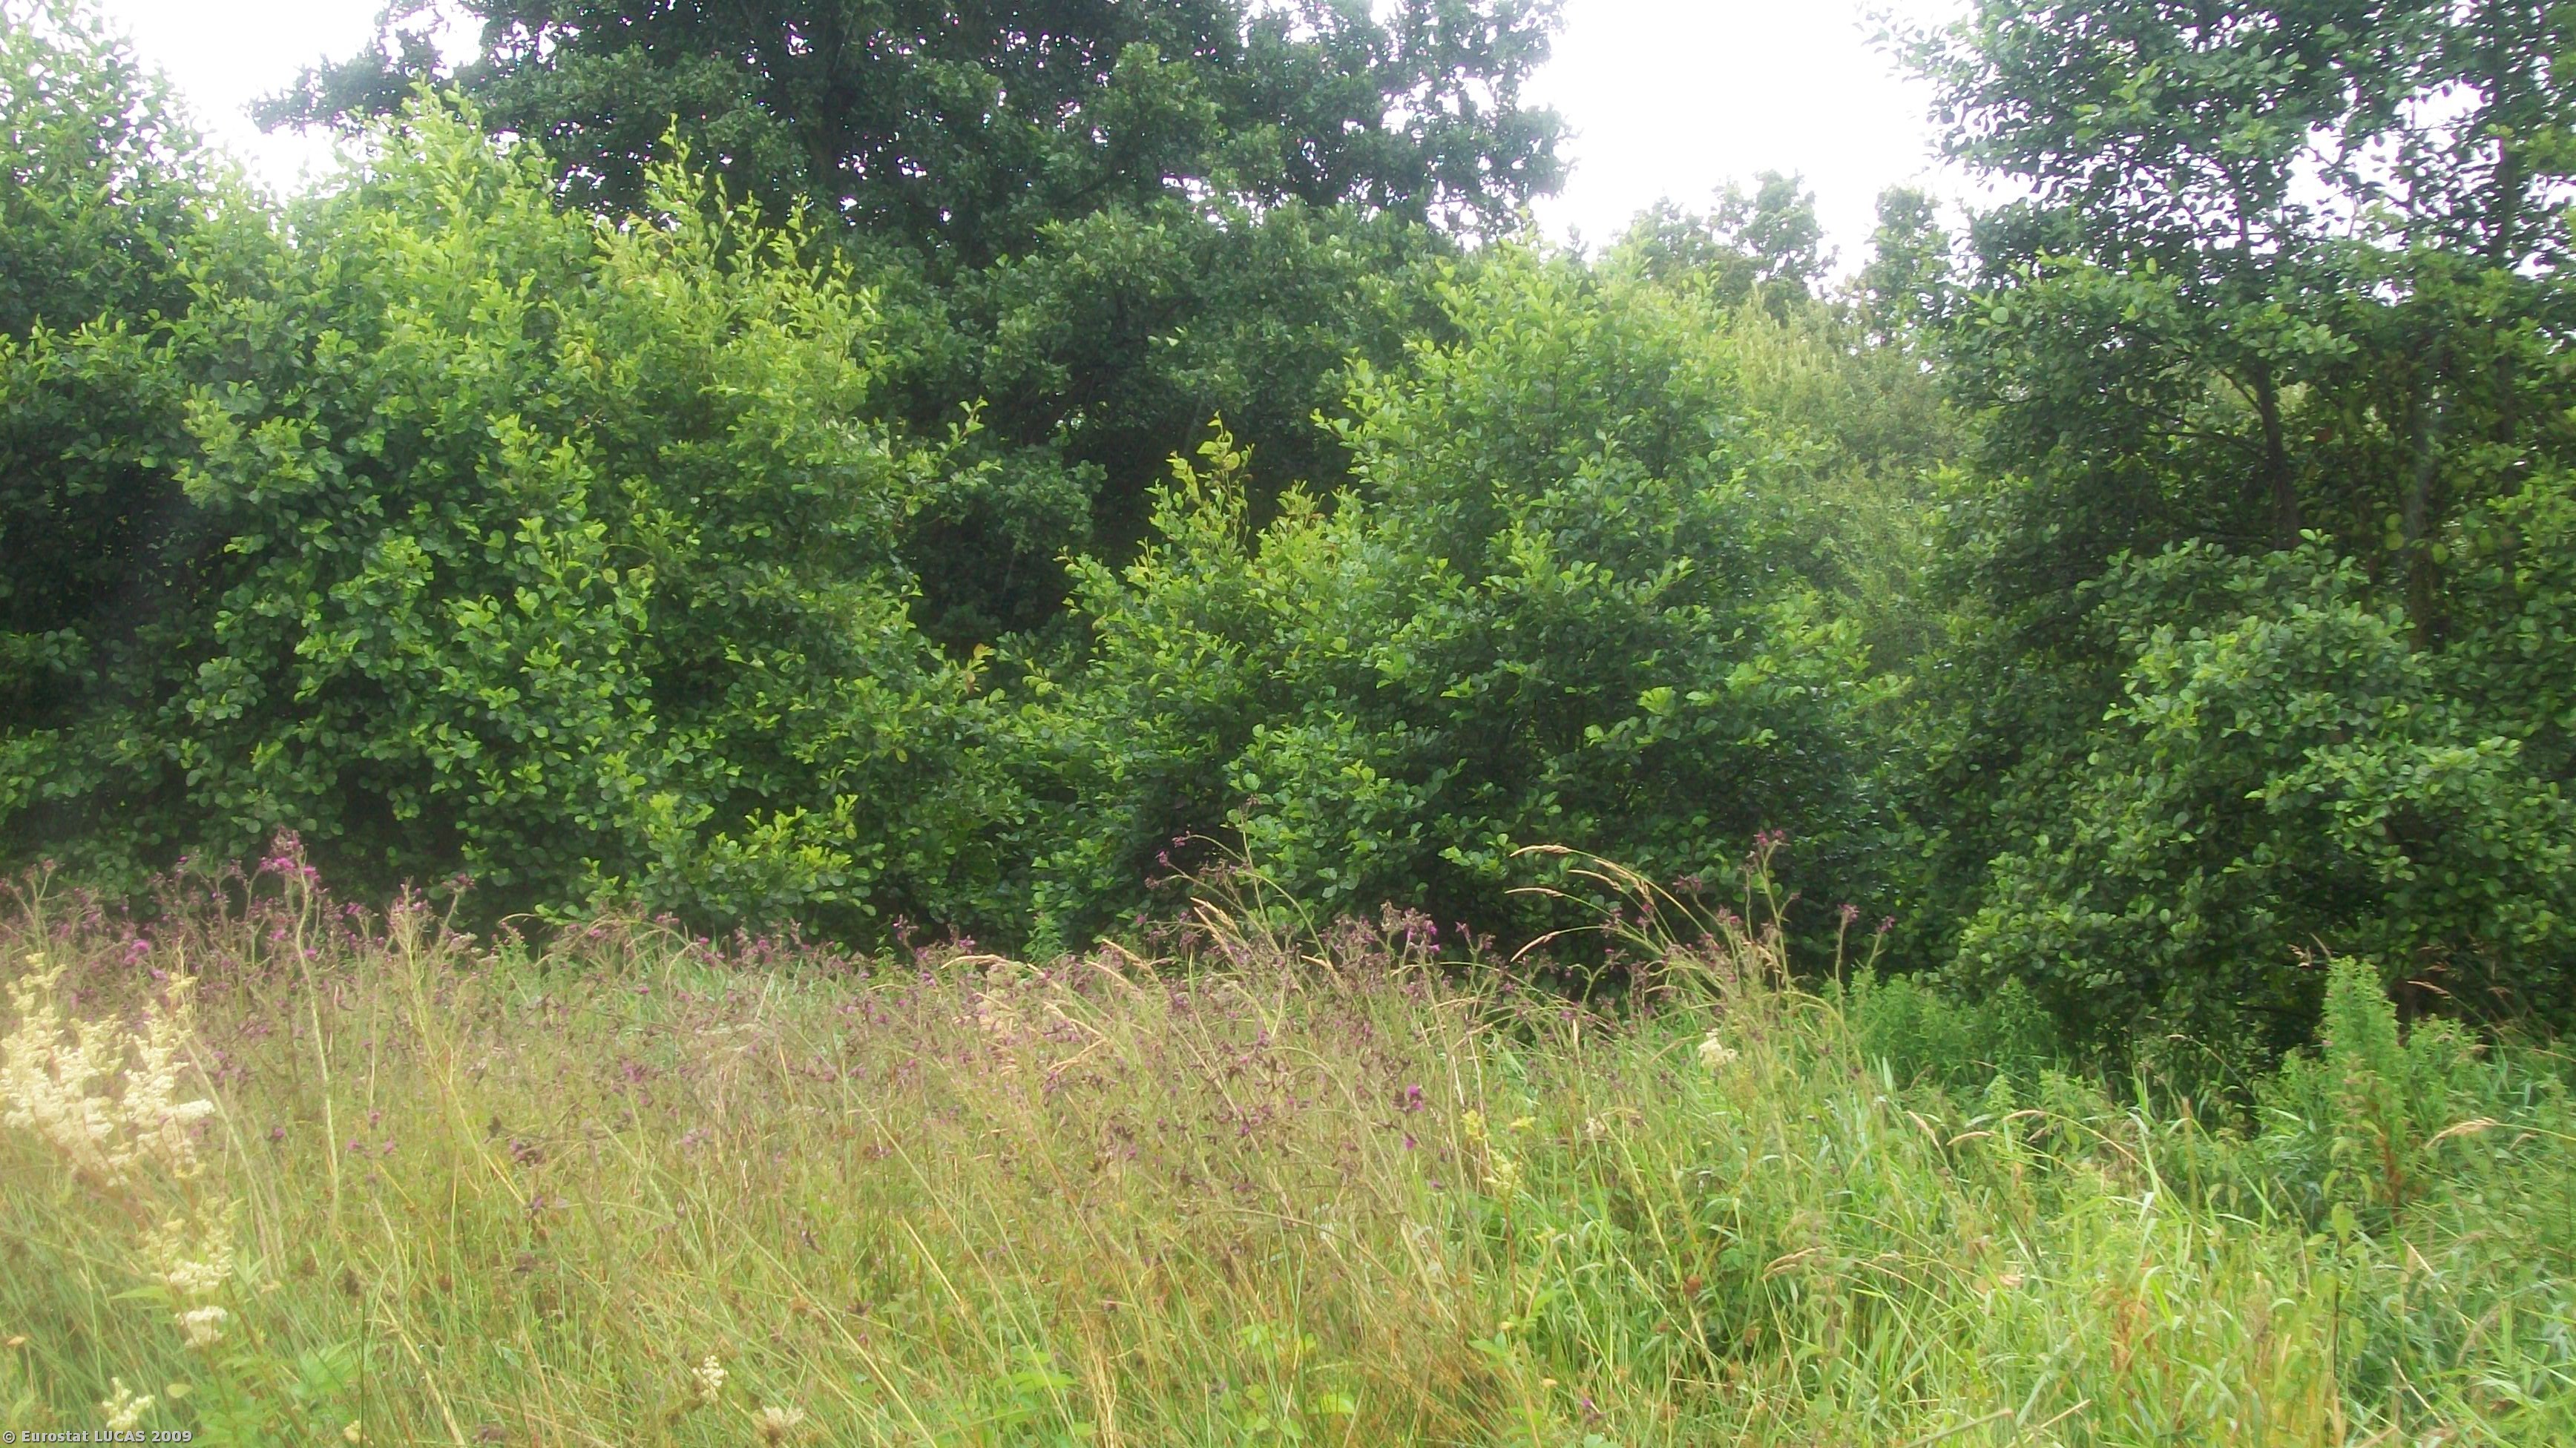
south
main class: Woodland
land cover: Broadleaved woodland
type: non-riverine alder, birch or aspen forest
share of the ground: > 75 %
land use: Unused
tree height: > 5 m
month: July
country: GB
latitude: 53.0070
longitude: -2.6617
